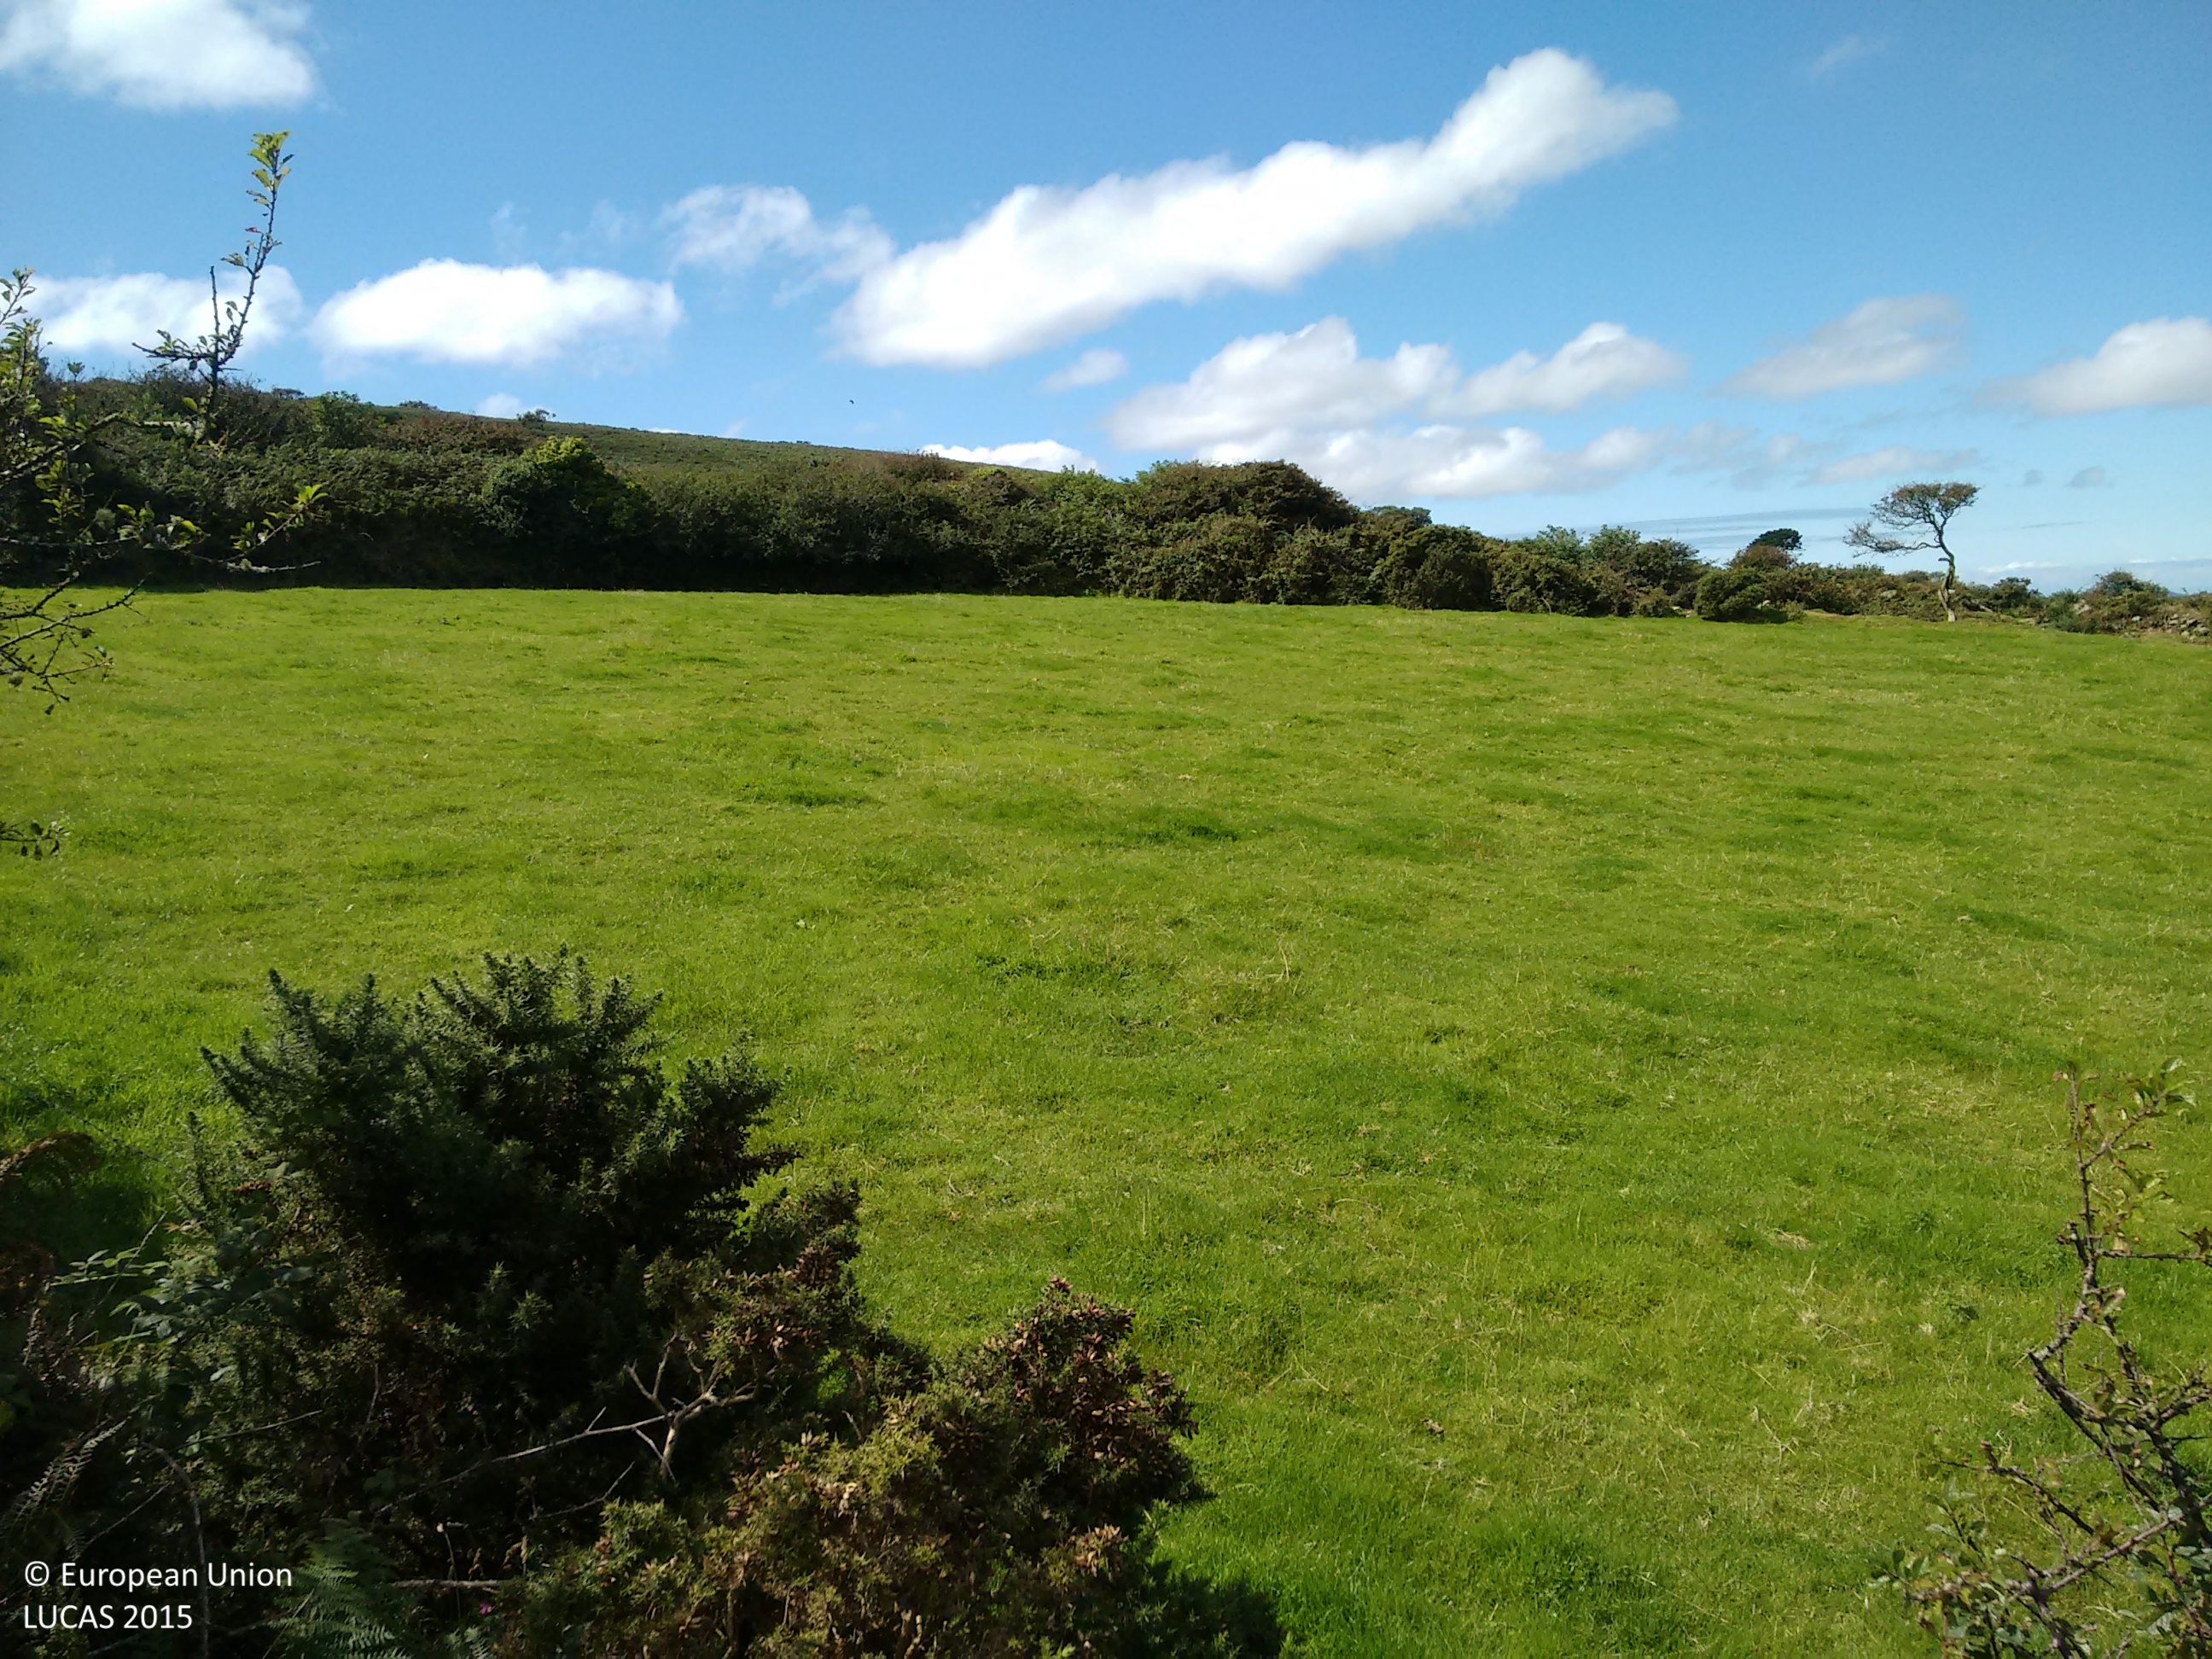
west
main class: Shrubland
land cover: Shrubland without tree cover
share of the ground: > 75 %
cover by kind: shrubs 70 %, herbaceous plants 30 %
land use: Agriculture (excluding fallow land and kitchen gardens)
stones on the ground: < 10 %
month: September
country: GB
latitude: 50.1244
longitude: -5.3562
